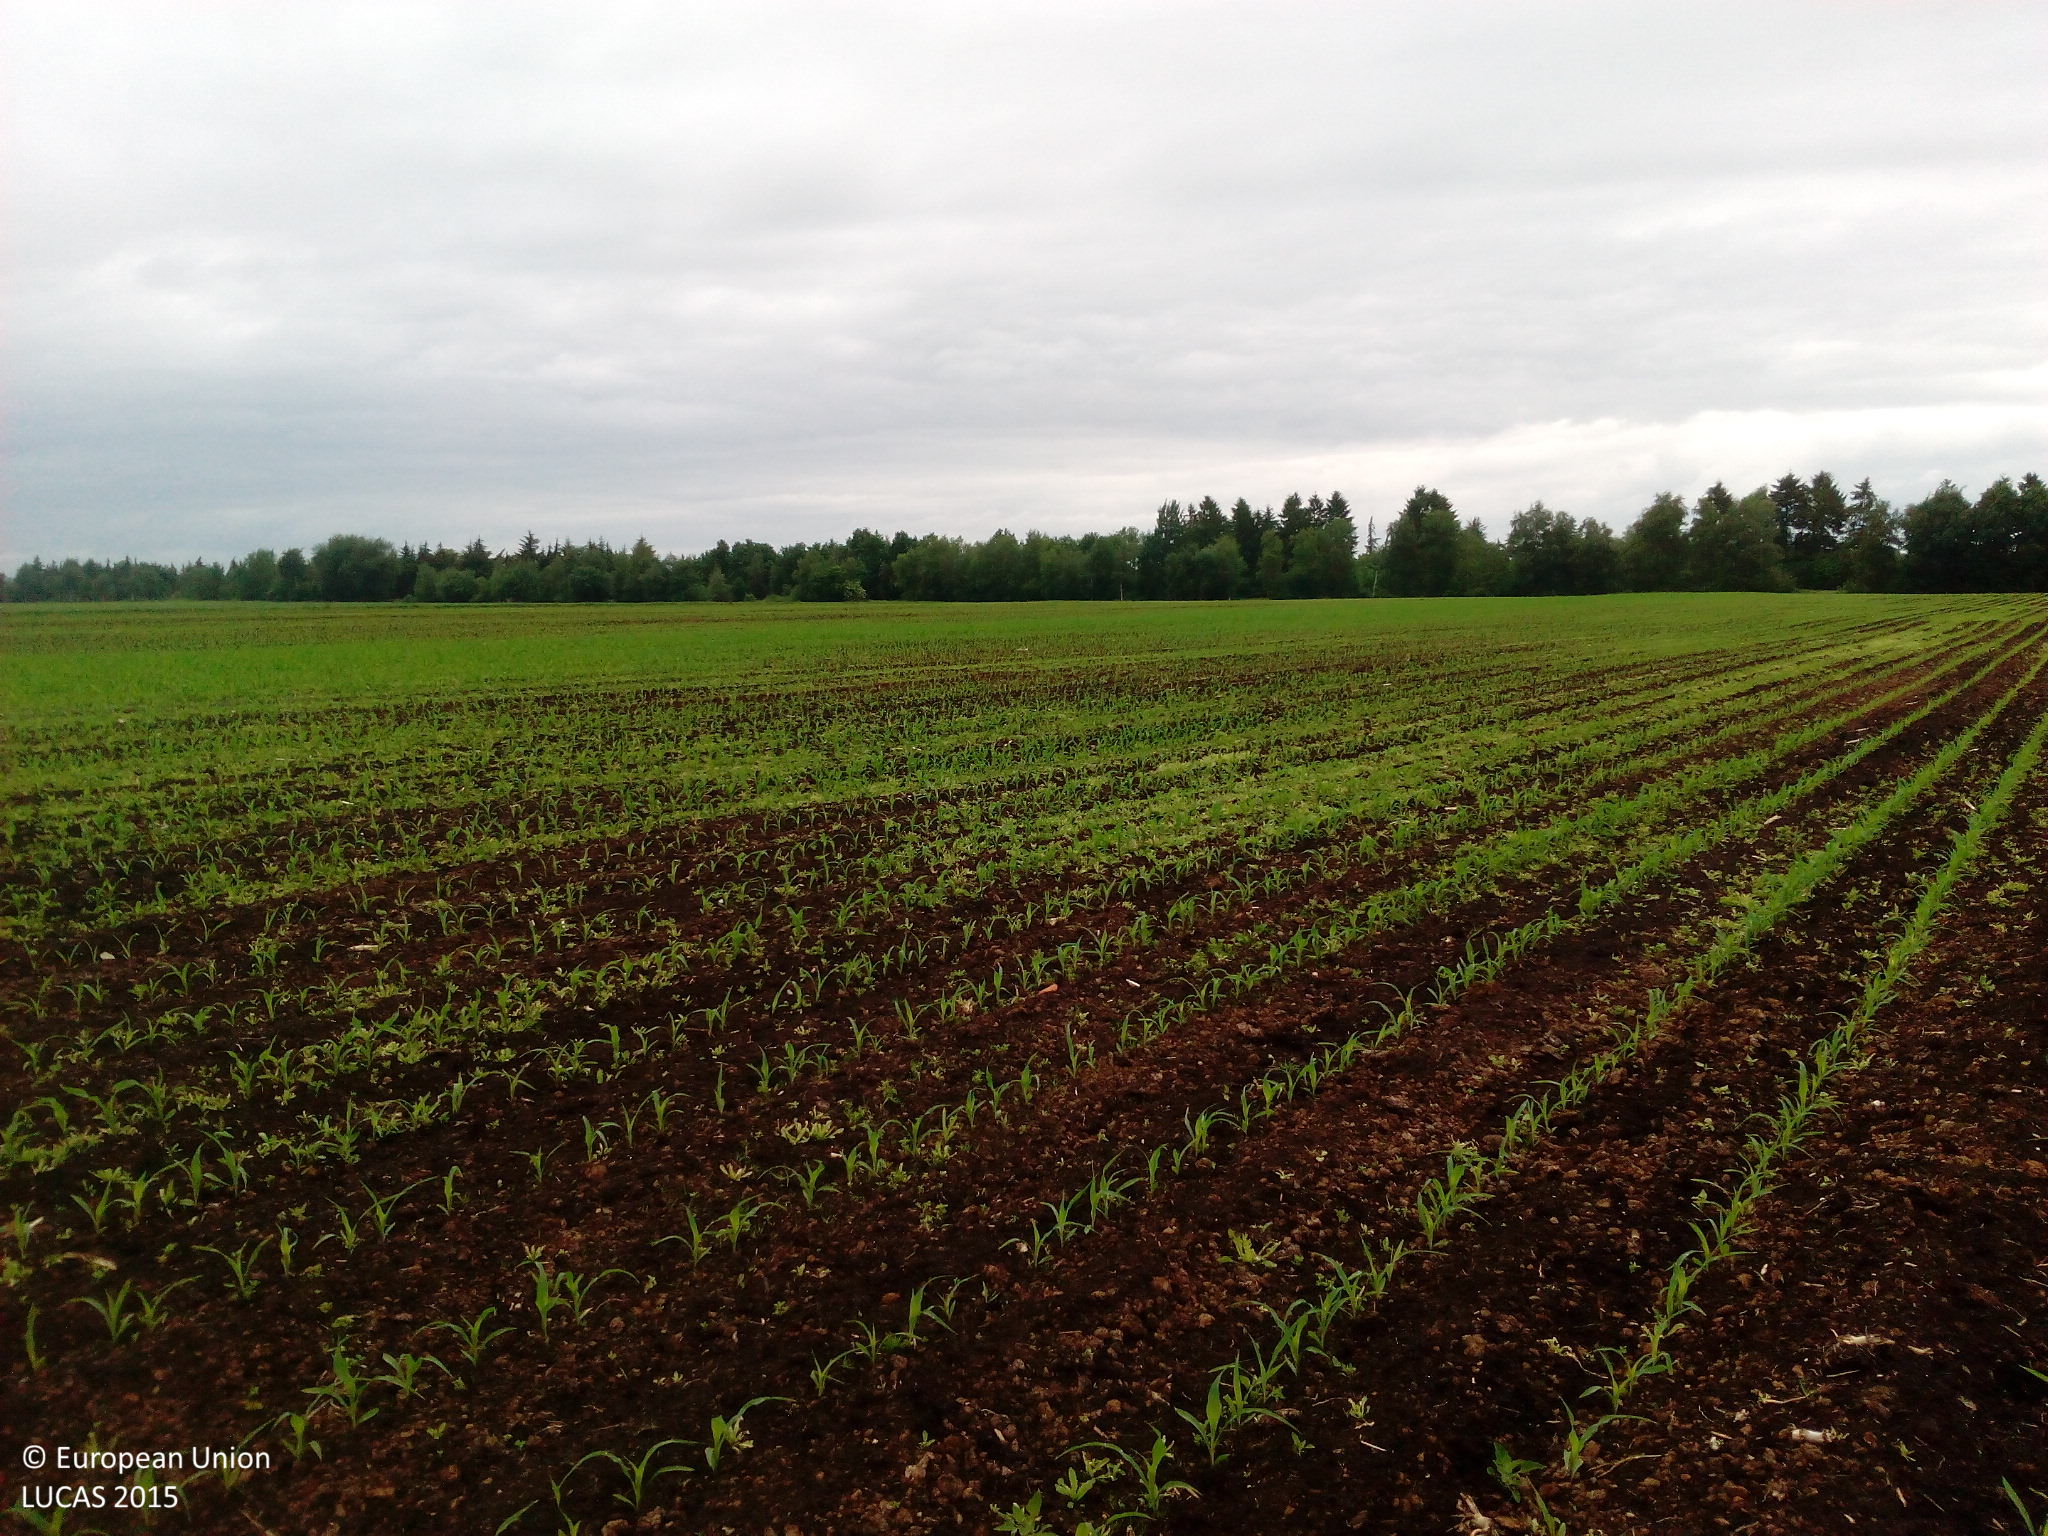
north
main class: Cropland
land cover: Maize
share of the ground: < 10 %
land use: Agriculture (excluding fallow land and kitchen gardens)
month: June
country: DE
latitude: 53.3984
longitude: 9.0830
